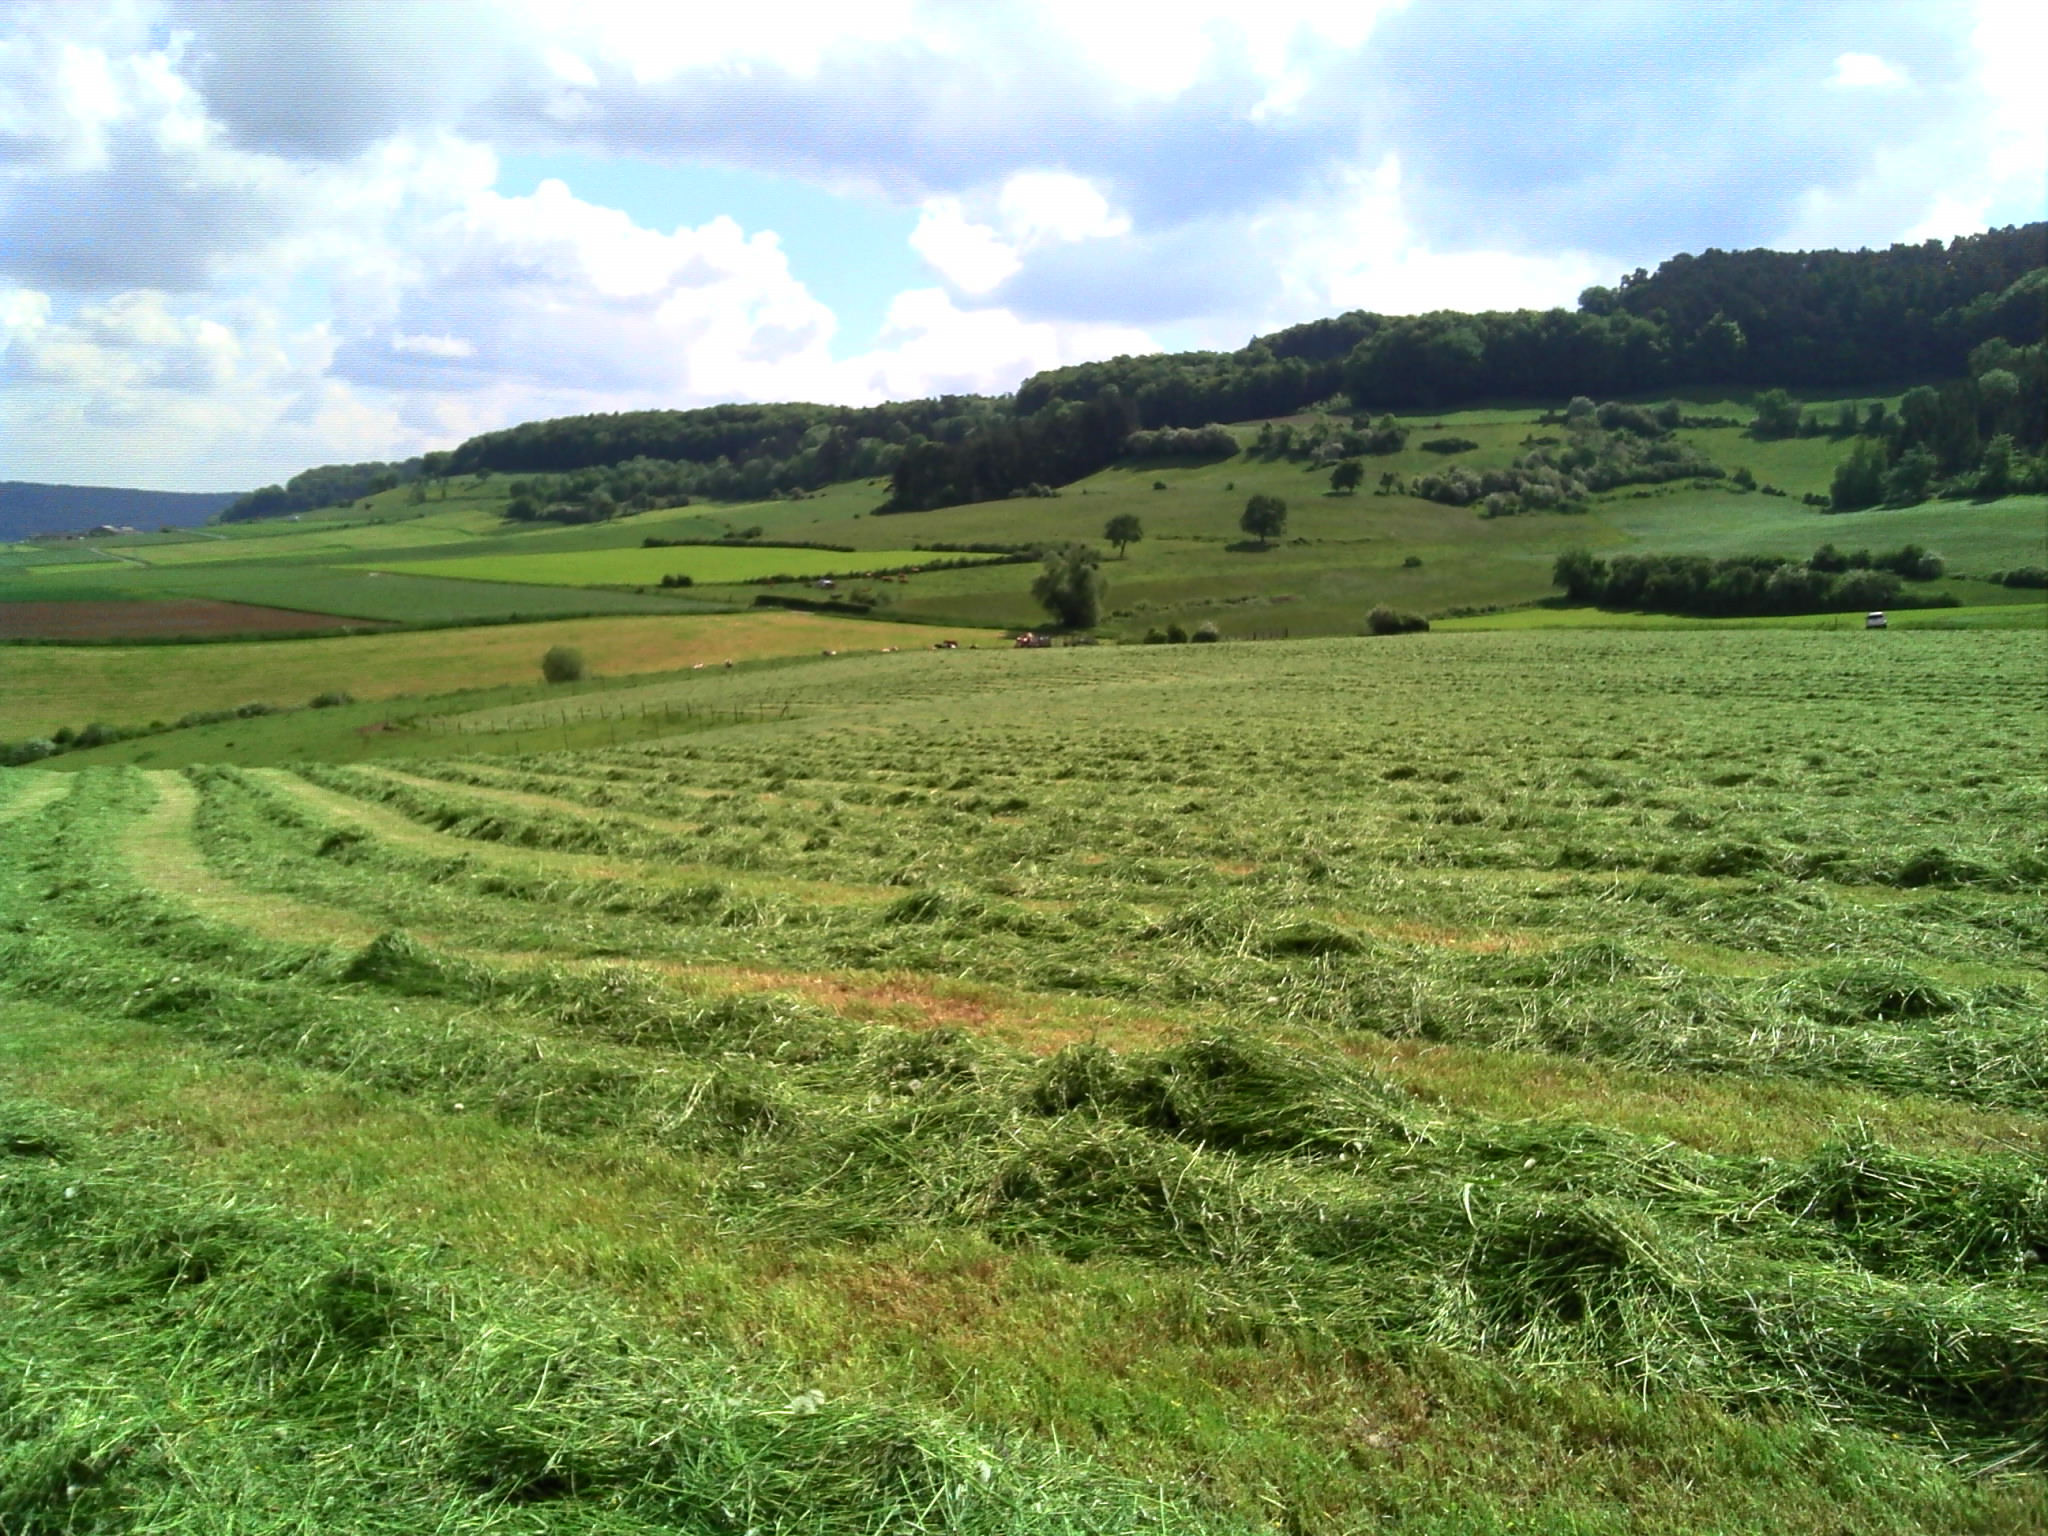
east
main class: Grassland
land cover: Grassland without tree/shrub cover
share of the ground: > 75 %
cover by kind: herbaceous plants 100 %
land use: Agriculture (excluding fallow land and kitchen gardens)
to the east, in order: Grassland without tree/shrub cover; Fences; Grassland without tree/shrub cover; Fences; Grass margins; Paved roads, cycling and walking lanes; Grass margins; Grassland without tree/shrub cover
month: May
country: LU
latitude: 49.8528
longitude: 6.2581
